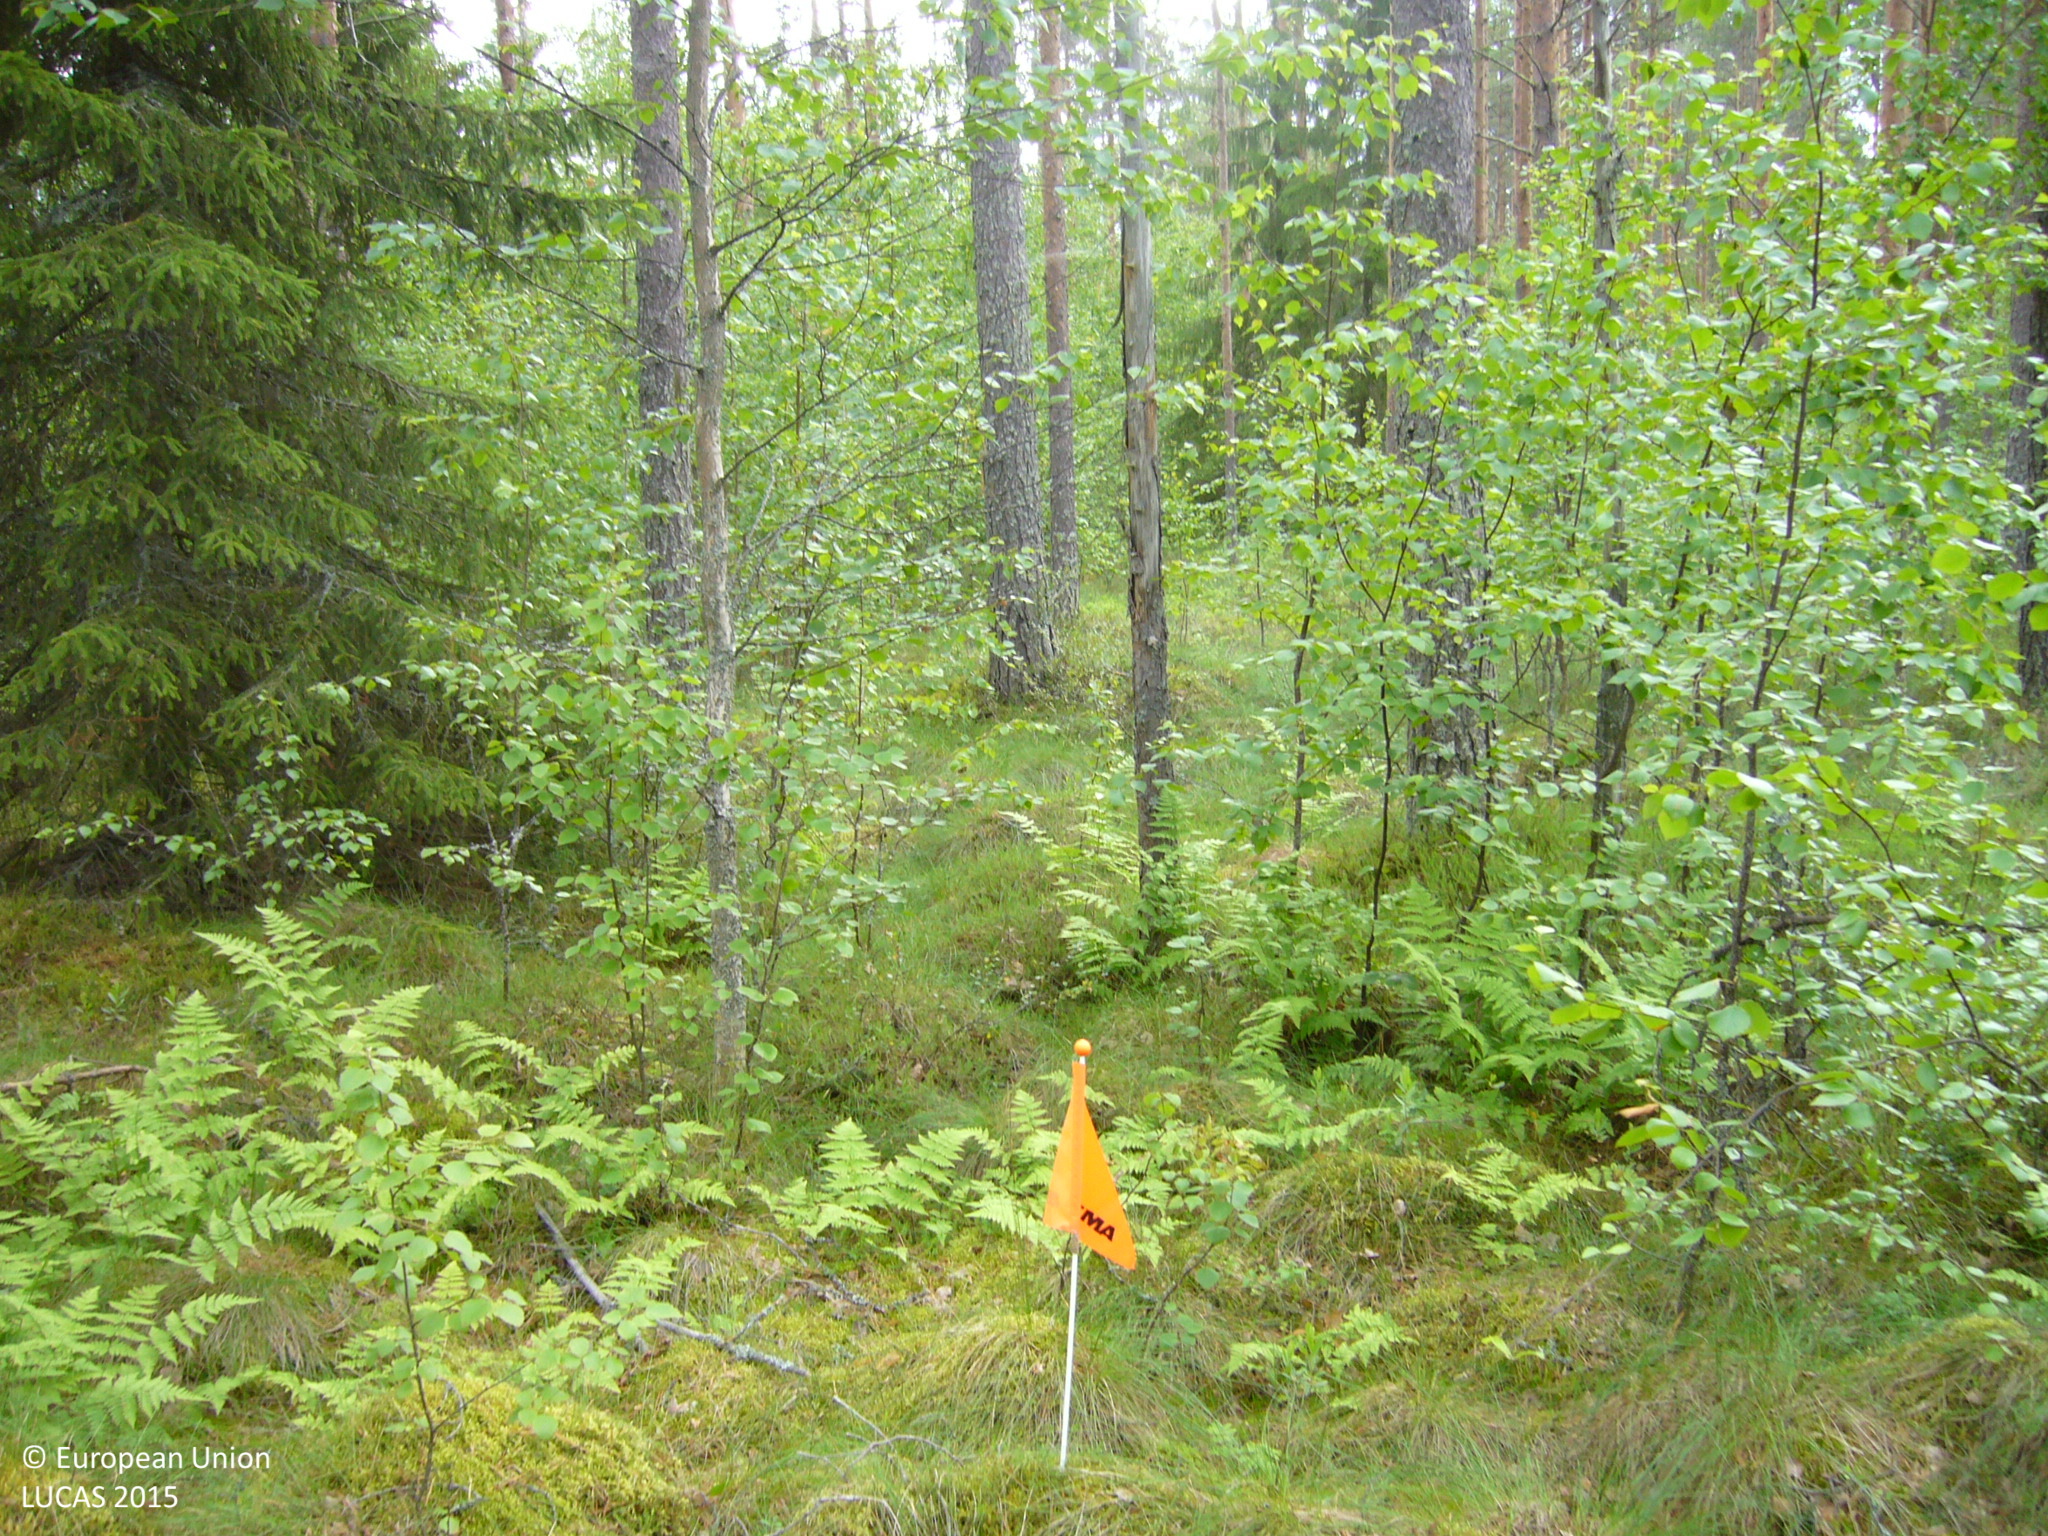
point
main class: Woodland
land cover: Pine dominated mixed woodland
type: boreal forest
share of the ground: 50 - 75 %
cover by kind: coniferous forest trees 40 %, shrubs 35 %, broadleaved forest trees 25 %
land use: Forestry
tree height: > 5 m
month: July
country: FI
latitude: 63.6276
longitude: 25.7023
